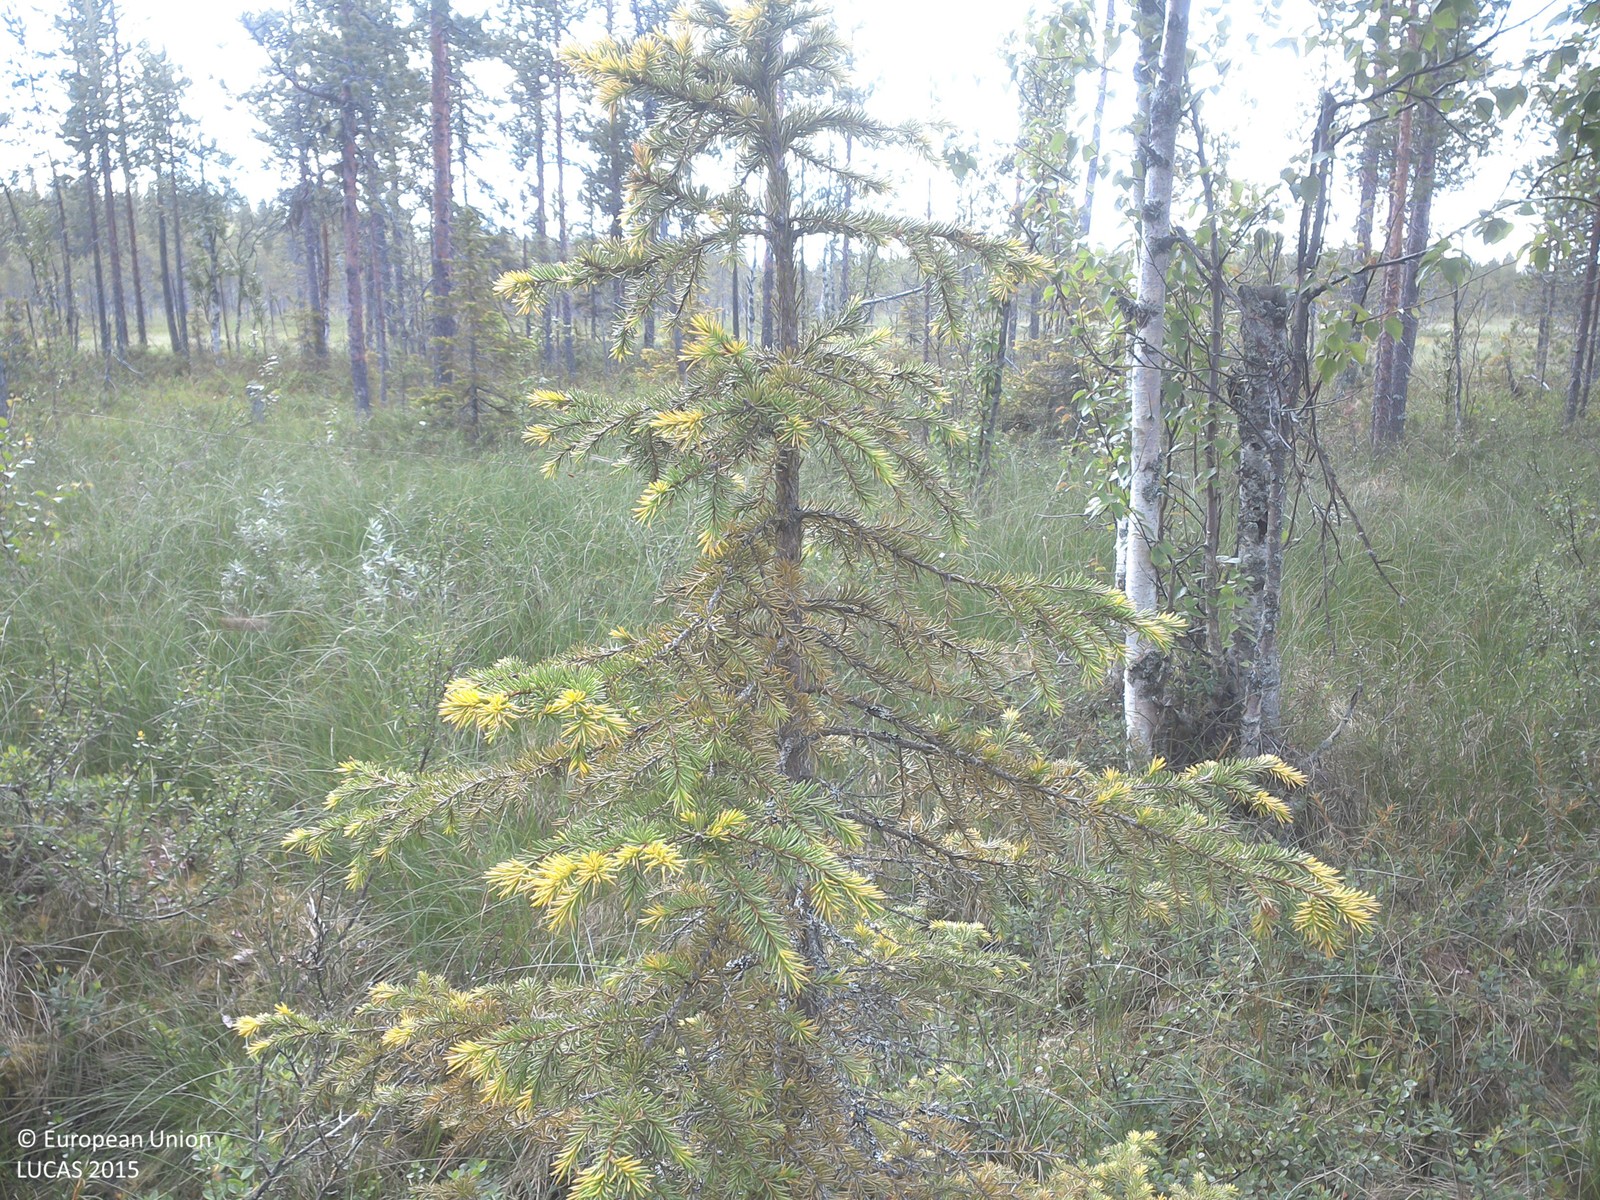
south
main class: Woodland
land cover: Pine dominated mixed woodland
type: boreal forest
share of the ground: 25 - 50 %
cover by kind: herbaceous plants 35 %, shrubs 30 %, coniferous forest trees 20 %, broadleaved forest trees 10 %, lichens and mosses 5 %
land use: Forestry
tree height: > 5 m
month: July
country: SE
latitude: 67.4386
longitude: 23.3512
